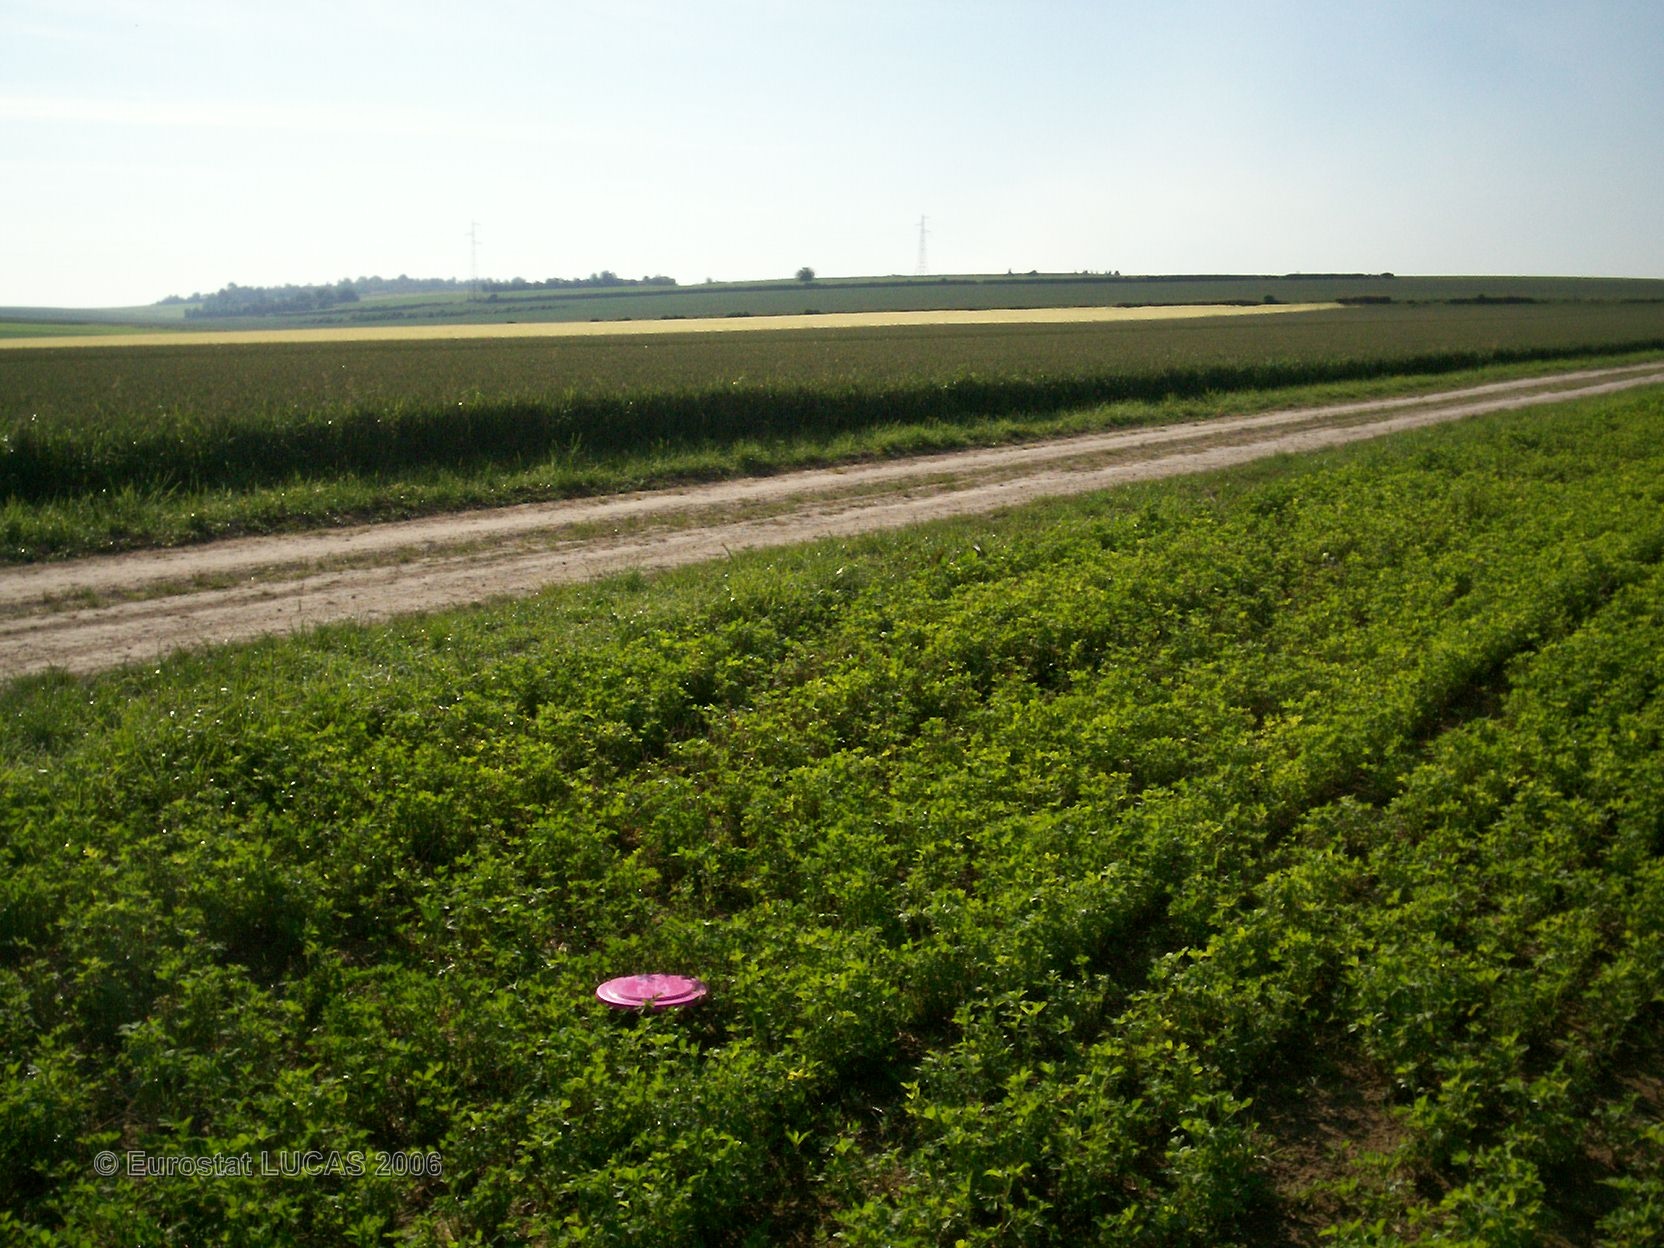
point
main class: Cropland
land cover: Lucerne
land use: Agriculture (excluding fallow land and kitchen gardens)
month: June
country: FR
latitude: 48.8964
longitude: 4.4723
